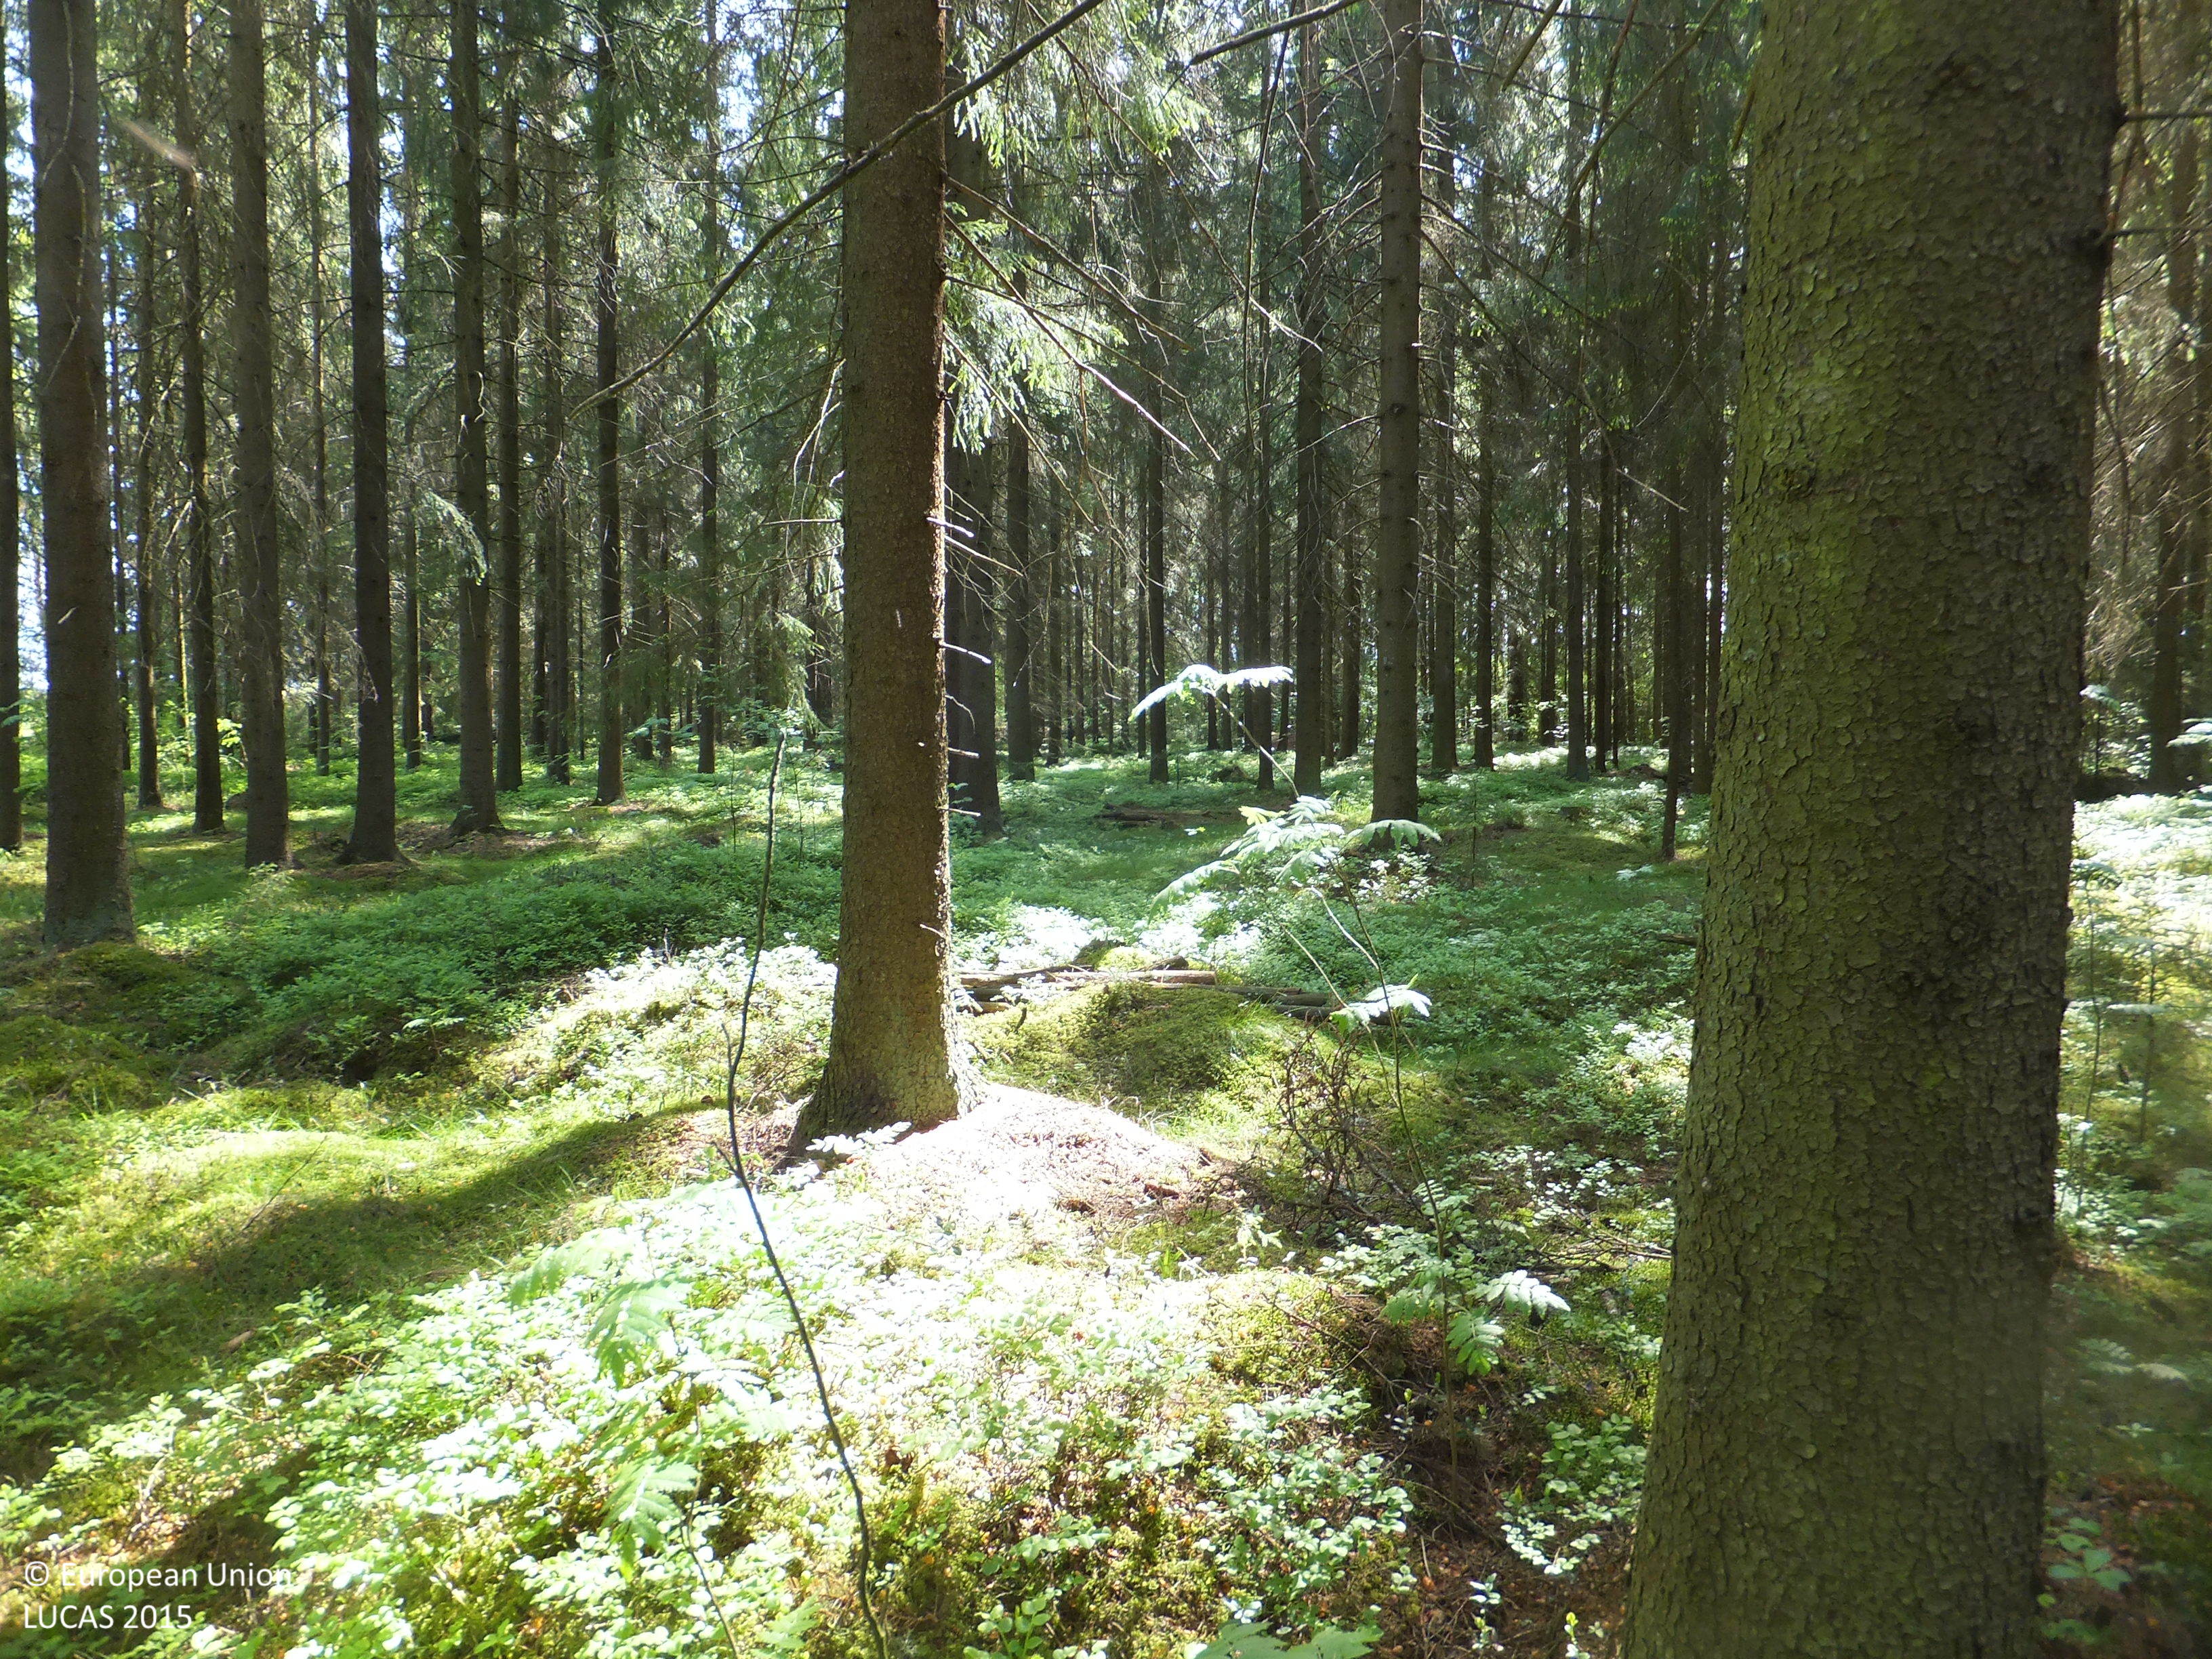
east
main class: Woodland
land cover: Spruce dominated coniferous woodland
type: boreal forest
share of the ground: > 75 %
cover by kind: coniferous forest trees 95 %, shrubs 5 %
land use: Forestry
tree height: > 5 m
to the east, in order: Spruce dominated coniferous woodland; Spruce dominated mixed woodland; Ditches and canals; Fences; Grassland without tree/shrub cover; Fences; Grass margins; Abandoned hedges; Ditches and canals; Grass margins; Barley
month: June
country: FI
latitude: 63.3458
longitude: 22.5772
